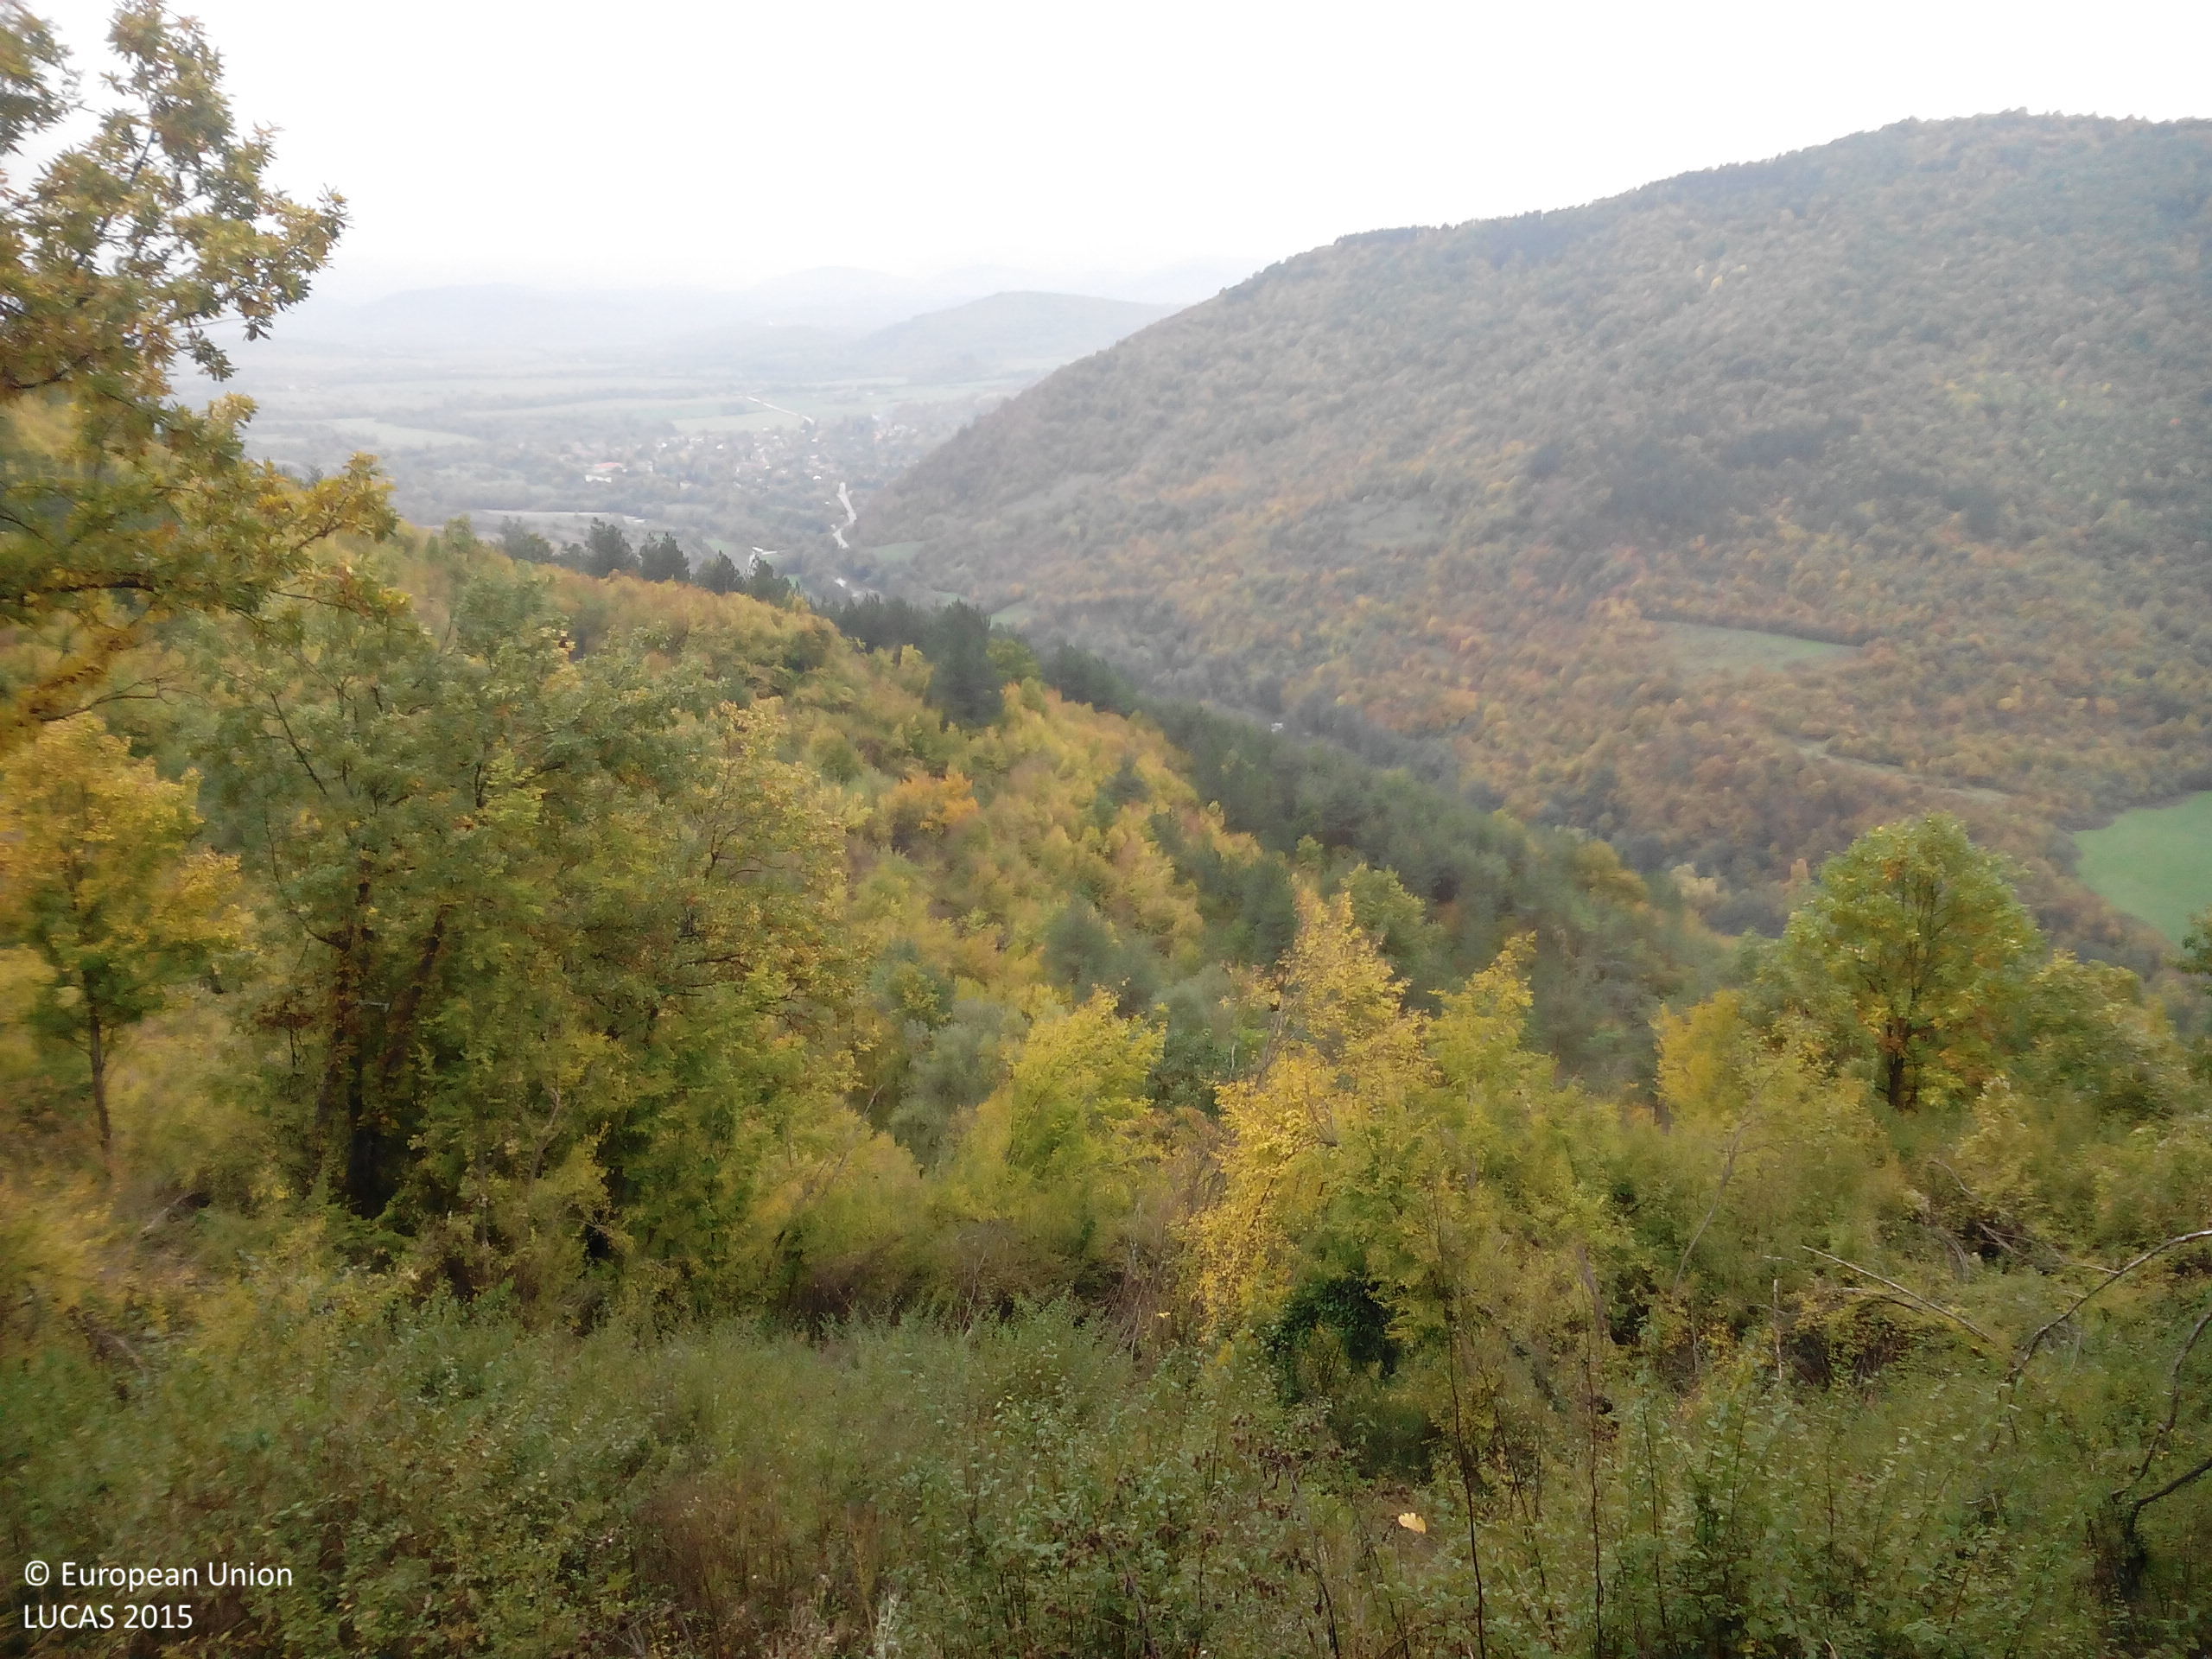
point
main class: Woodland
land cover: Broadleaved woodland
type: mesophytic deciduous forest
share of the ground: > 75 %
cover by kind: broadleaved forest trees 80 %, shrubs 10 %, herbaceous plants 10 %
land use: Abandoned areas
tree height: > 5 m
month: October
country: BG
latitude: 43.0123
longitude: 23.9980
